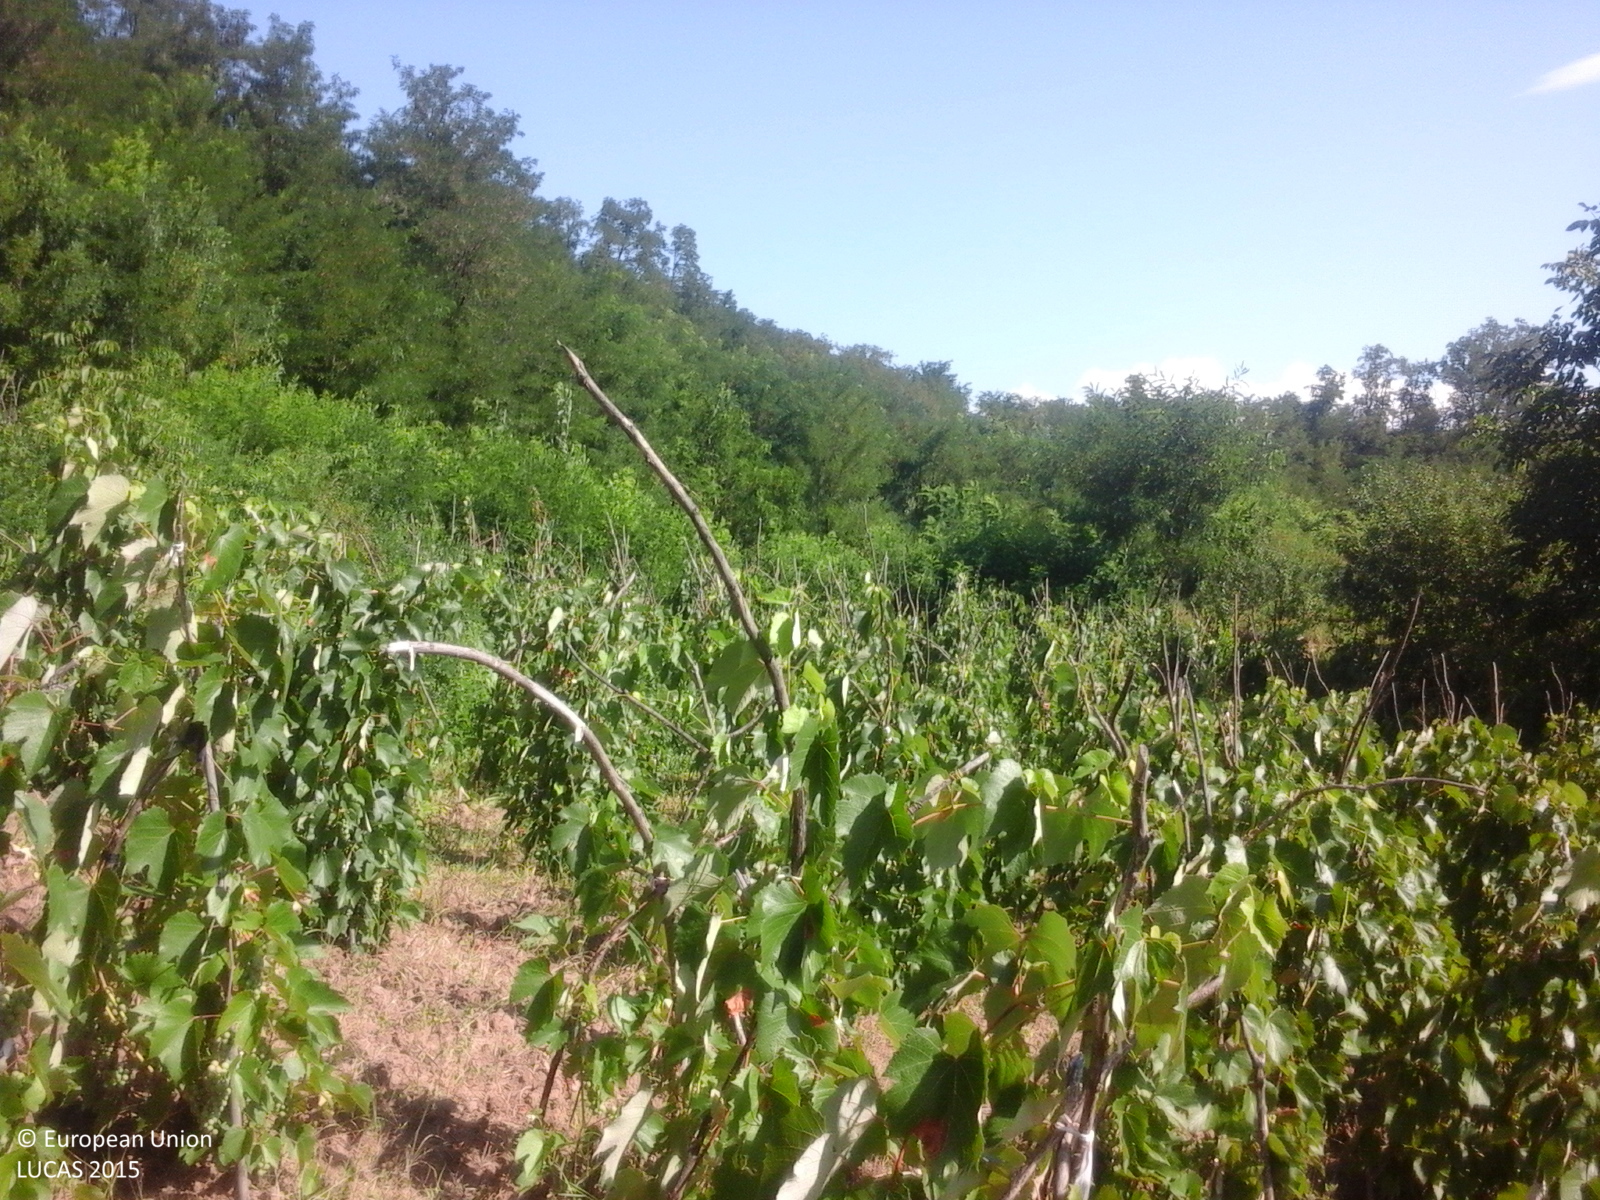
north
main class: Cropland
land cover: Vineyards
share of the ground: > 75 %
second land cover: Other bare soil
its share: > 75 %
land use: Agriculture (excluding fallow land and kitchen gardens)
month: July
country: RO
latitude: 46.4373
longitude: 27.2973
